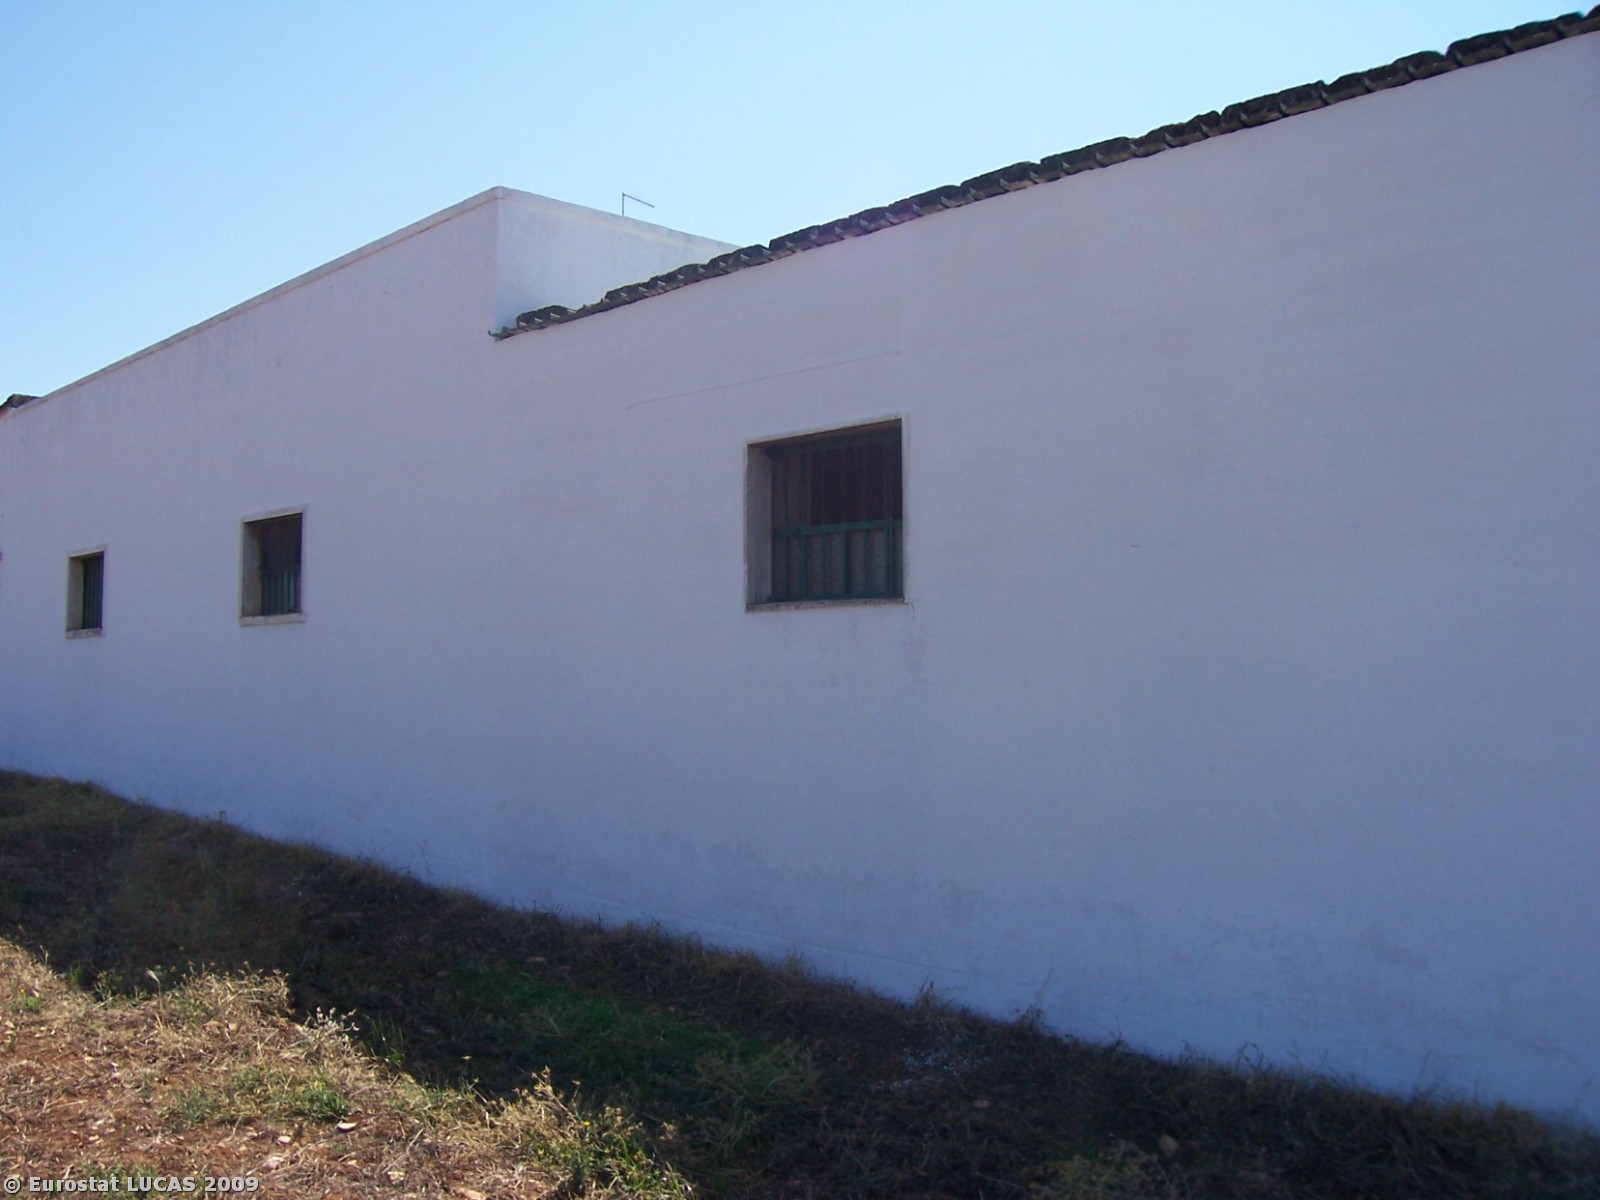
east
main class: Cropland
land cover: Temporary grasslands
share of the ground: 50 - 75 %
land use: Agriculture (excluding fallow land and kitchen gardens)
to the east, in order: Temporary grasslands; Artificial constructions in urban areas; Electric lines; Mixed cereals for fodder; Grass margins; Dry stone walls; Tracks; Dry stone walls; Olive groves; Spontaneously vegetated surfaces; Dry stone walls; Mixed cereals for fodder; Dry stone walls; Nuts trees; Spontaneously vegetated surfaces; Dry stone walls; Spontaneously vegetated surfaces
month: July
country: IT
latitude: 40.7416
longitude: 17.0234
